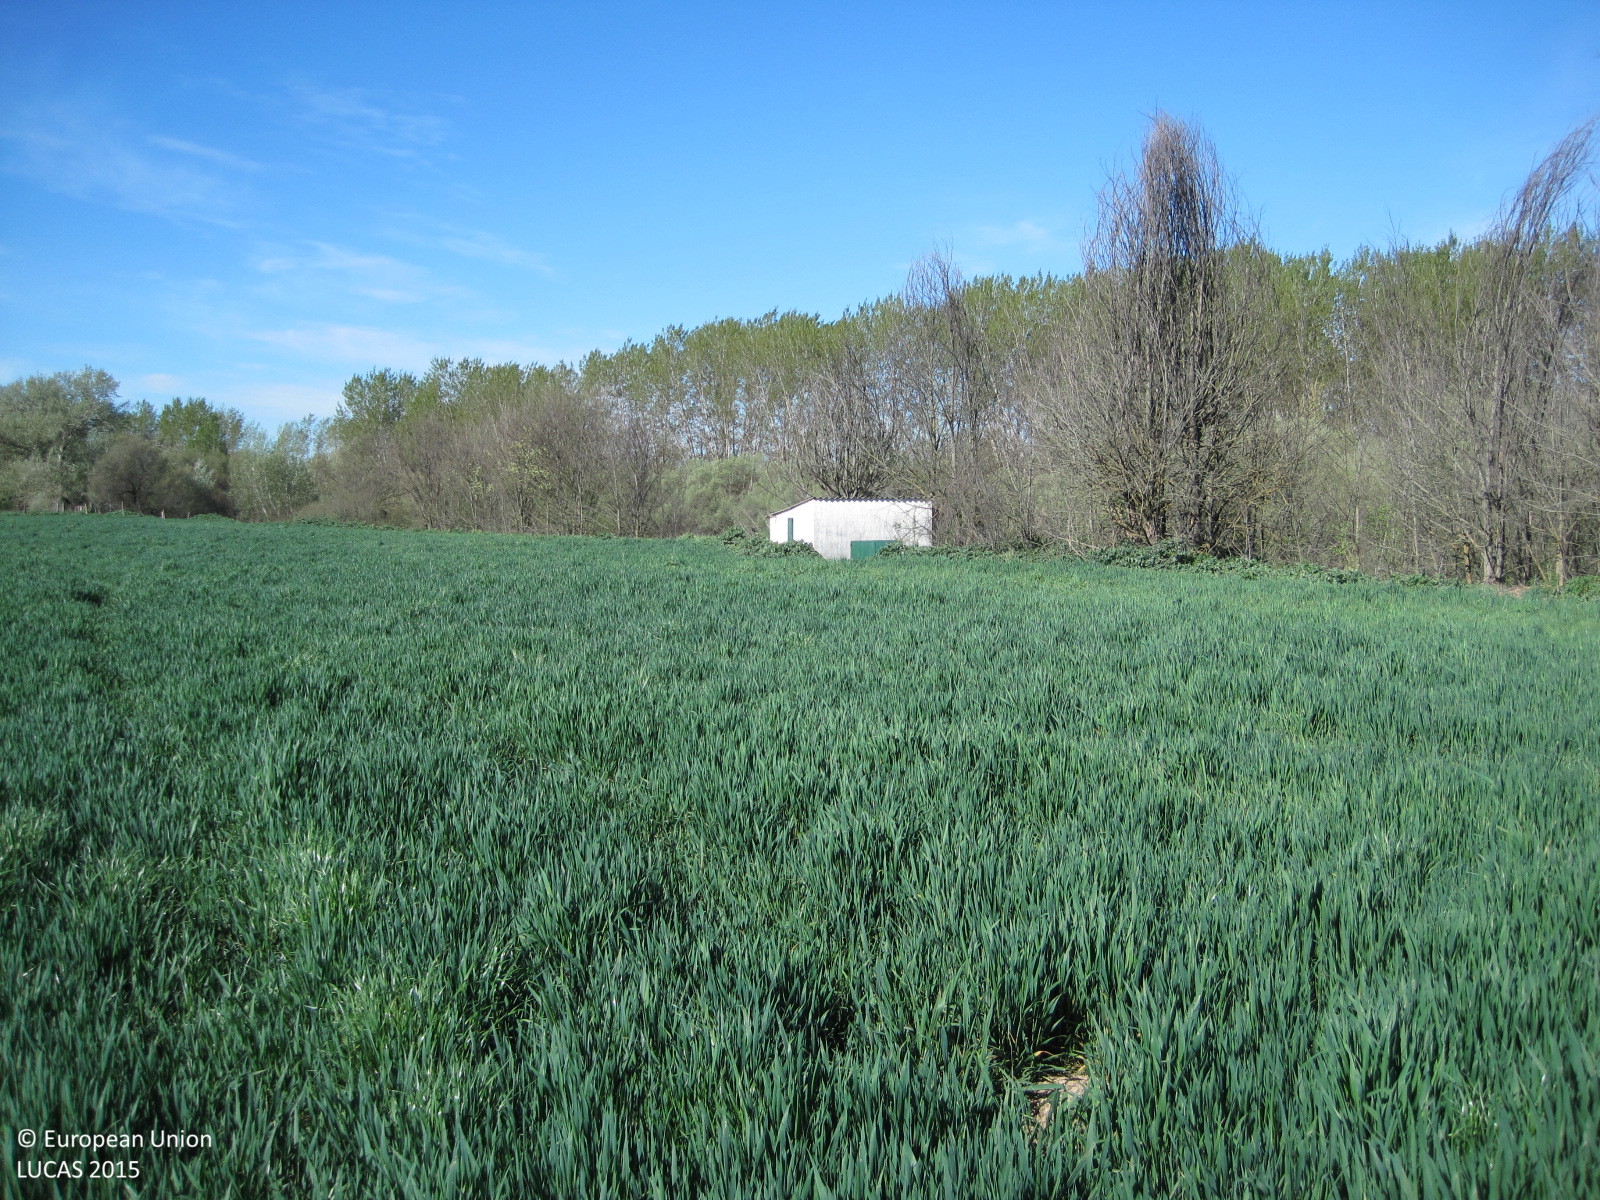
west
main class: Cropland
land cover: Barley
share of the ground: > 75 %
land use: Agriculture (excluding fallow land and kitchen gardens)
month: April
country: ES
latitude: 39.9696
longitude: -4.7639
